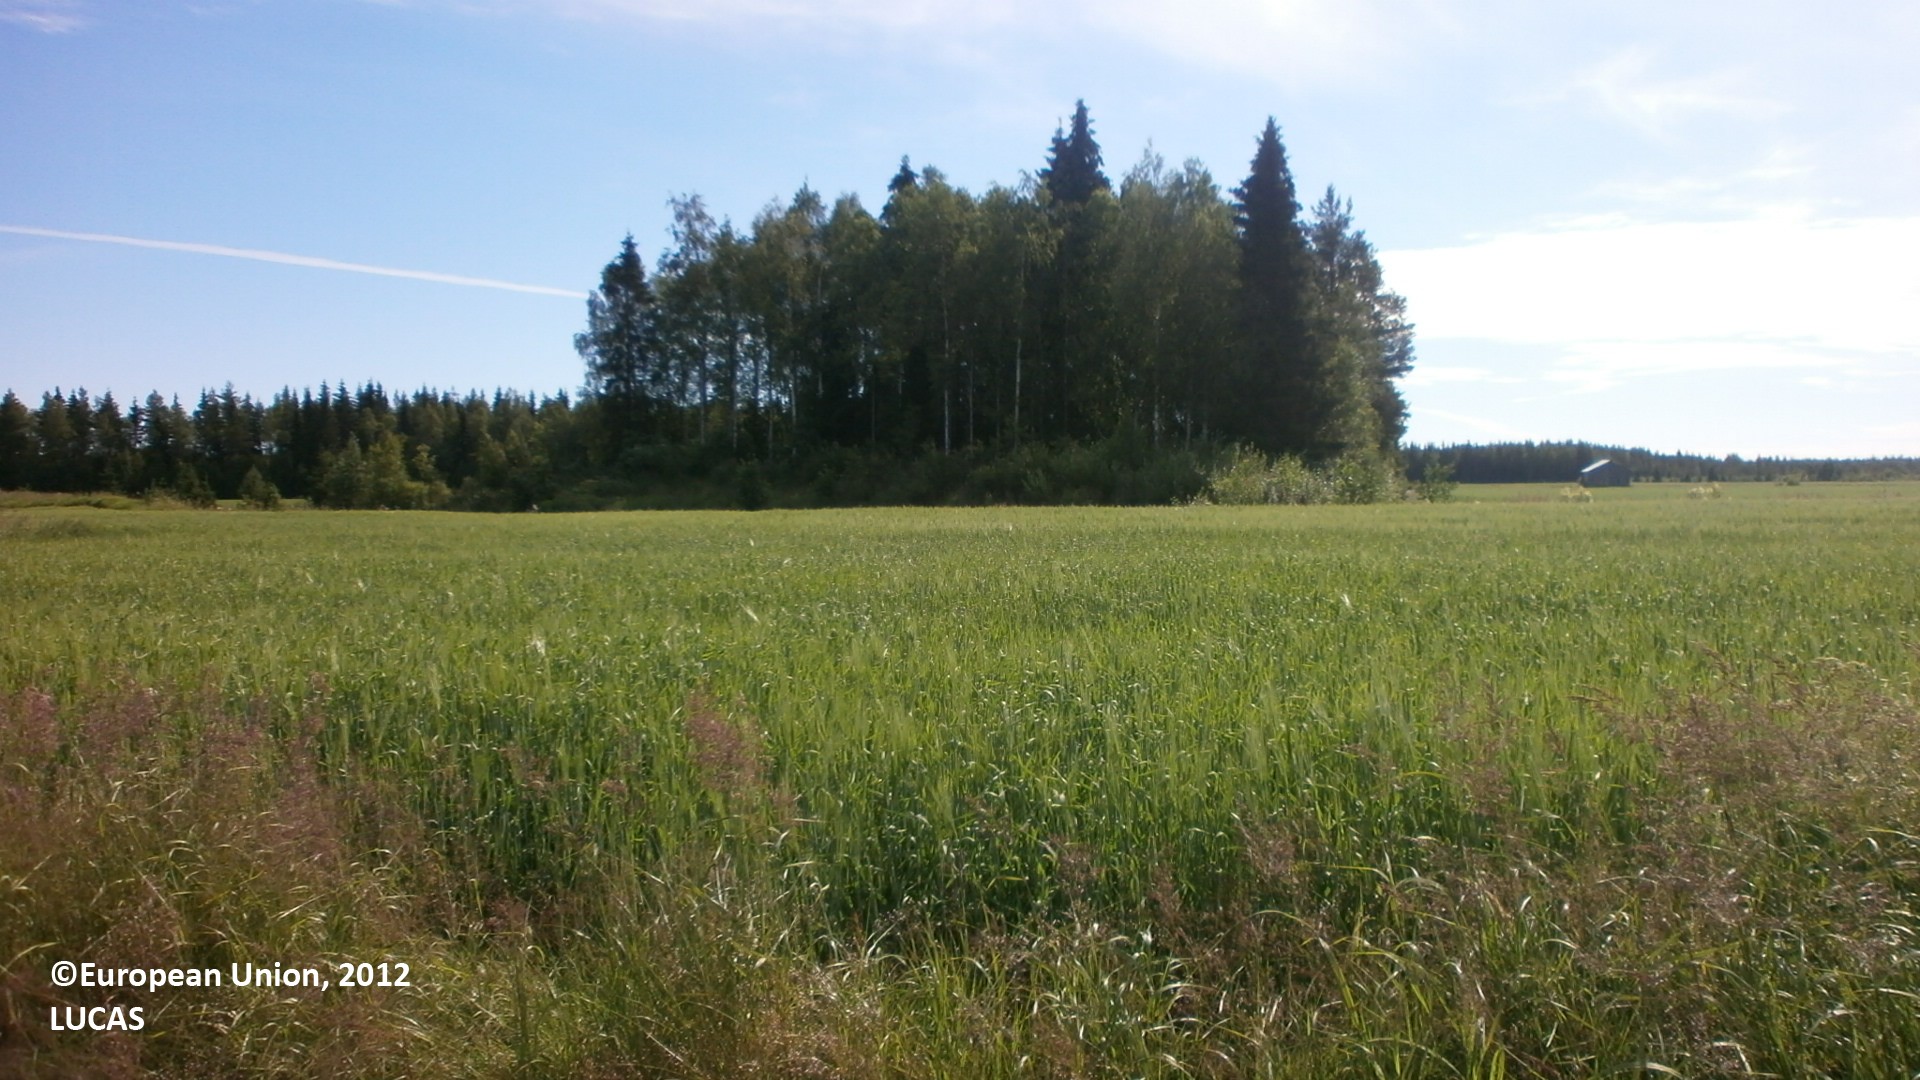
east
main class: Cropland
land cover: Oats
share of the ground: > 75 %
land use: Agriculture (excluding fallow land and kitchen gardens)
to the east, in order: Oats; Shruby margins; Ditches and canals; Shruby margins; Barley; Shruby margins; Ditches and canals; Grassland with sparse tree/shrub cover; Spruce dominated mixed woodland; Ditches and canals; Grass margins; Barley
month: July
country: FI
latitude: 64.4007
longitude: 24.1907
